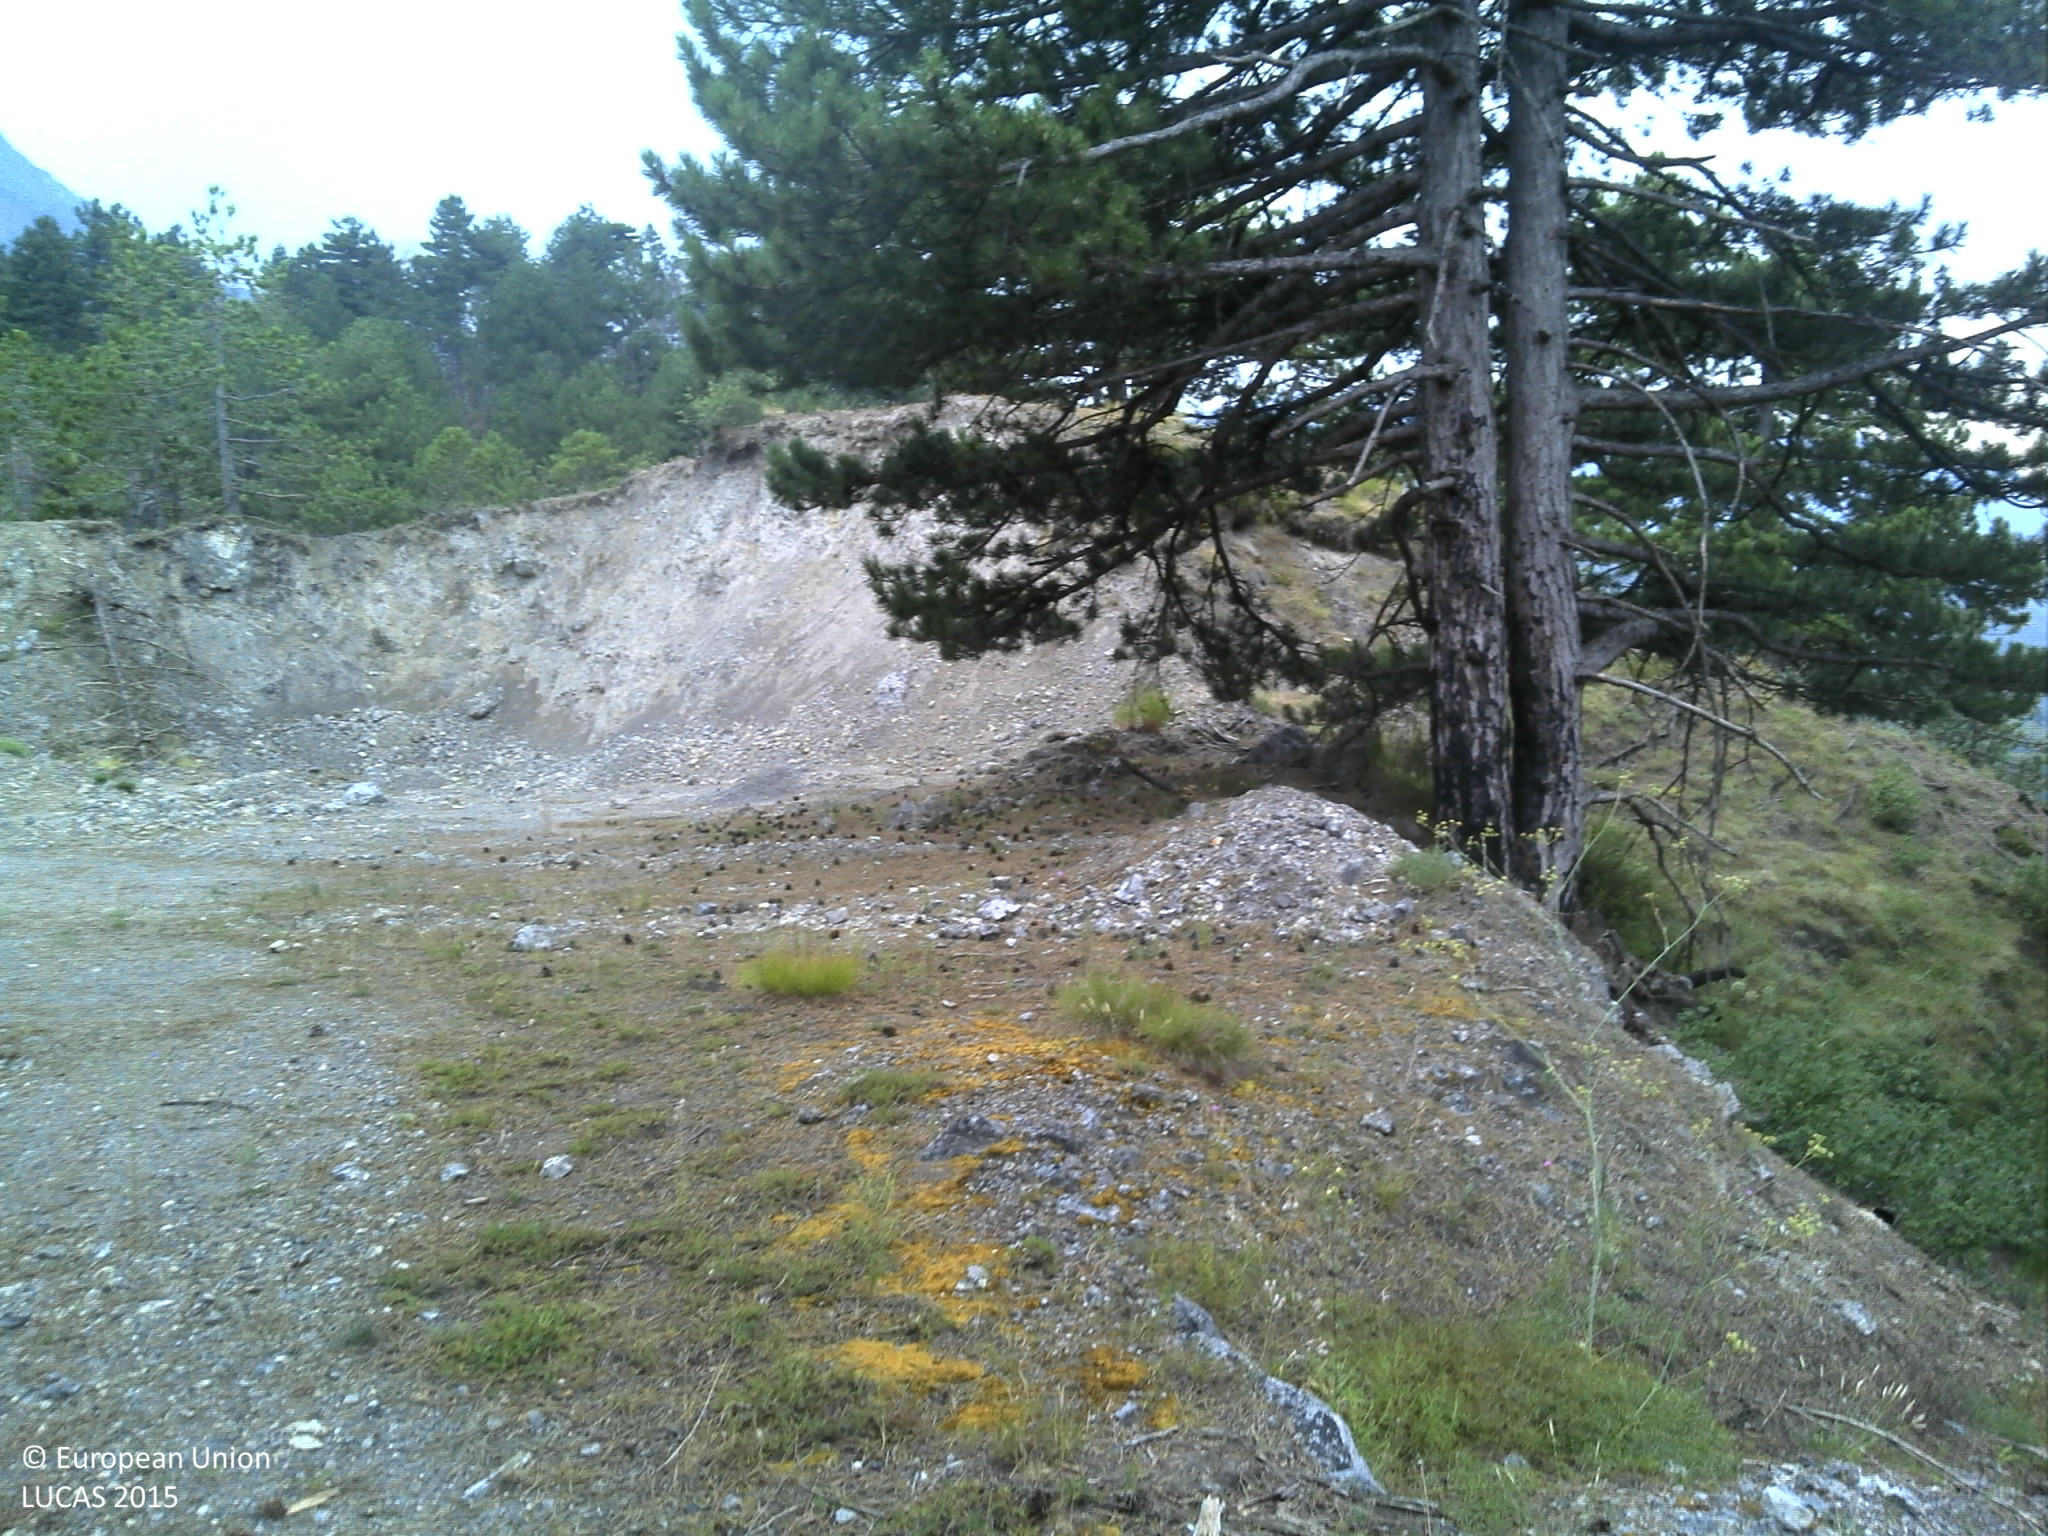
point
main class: Woodland
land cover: Pine dominated coniferous woodland
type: coniferous forest of the mediterranean region
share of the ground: > 75 %
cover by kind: coniferous forest trees 75 %, herbaceous plants 20 %, shrubs 5 %
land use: Semi-natural and natural areas not in use
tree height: > 5 m
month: July
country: HR
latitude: 44.3488
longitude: 16.1530
